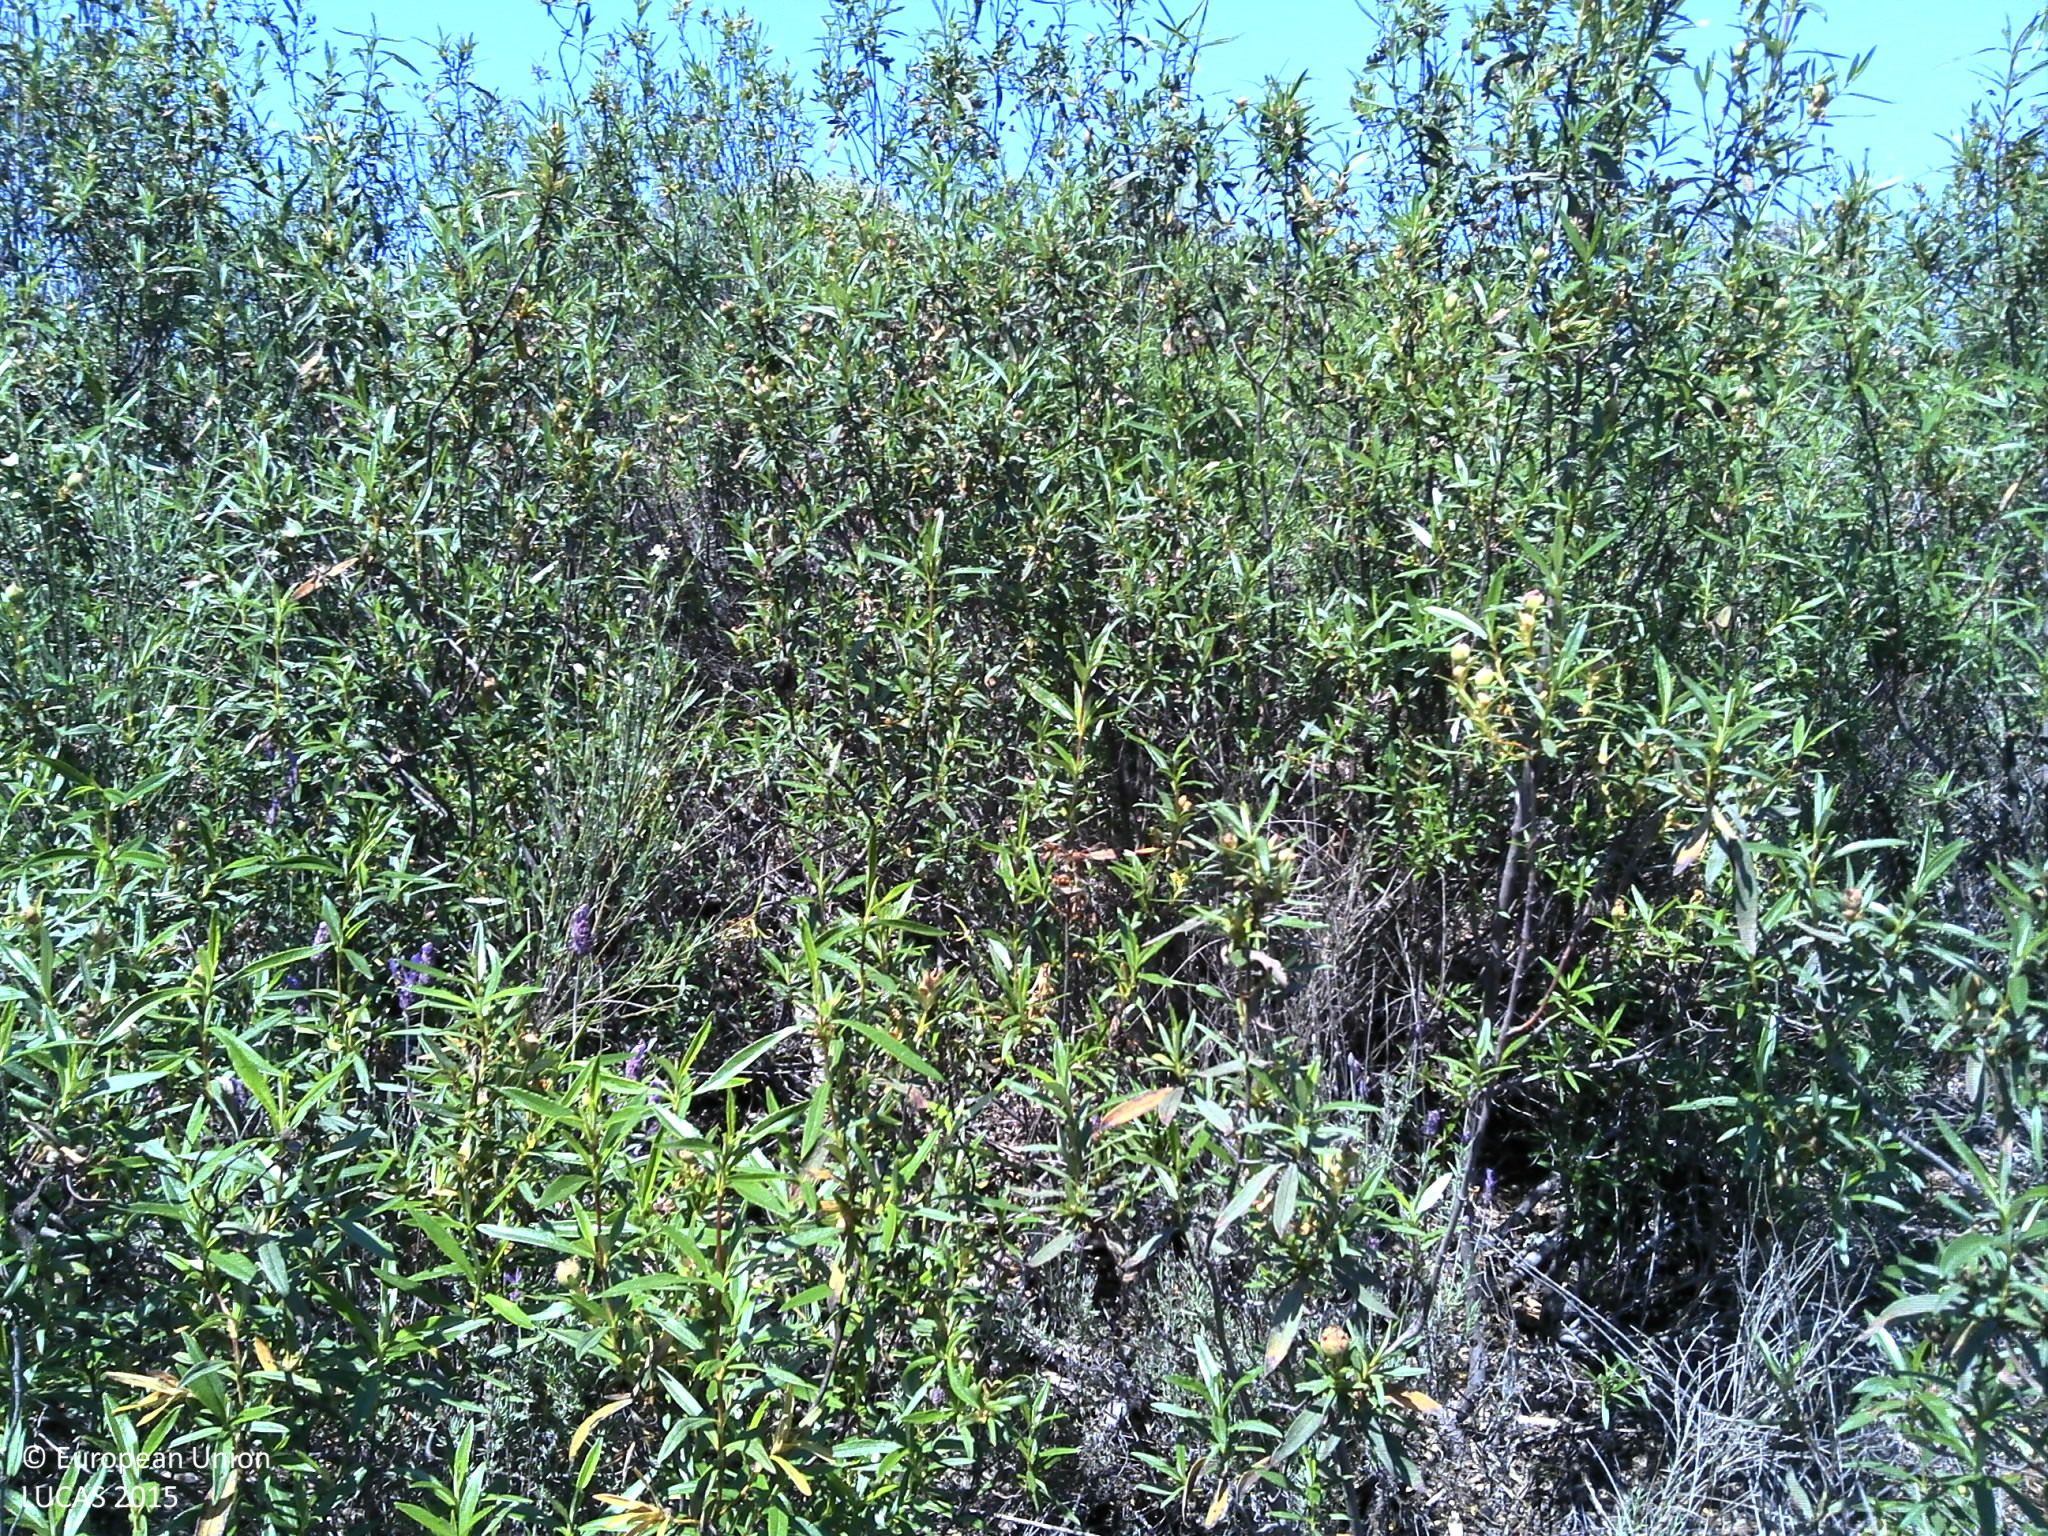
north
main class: Shrubland
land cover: Shrubland with sparse tree cover
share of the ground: 50 - 75 %
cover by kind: shrubs 65 %, unconsolidated bare surface 30 %, coniferous forest trees 5 %
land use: Forestry
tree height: > 5 m
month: May
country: PT
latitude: 41.6070
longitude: -7.5409
